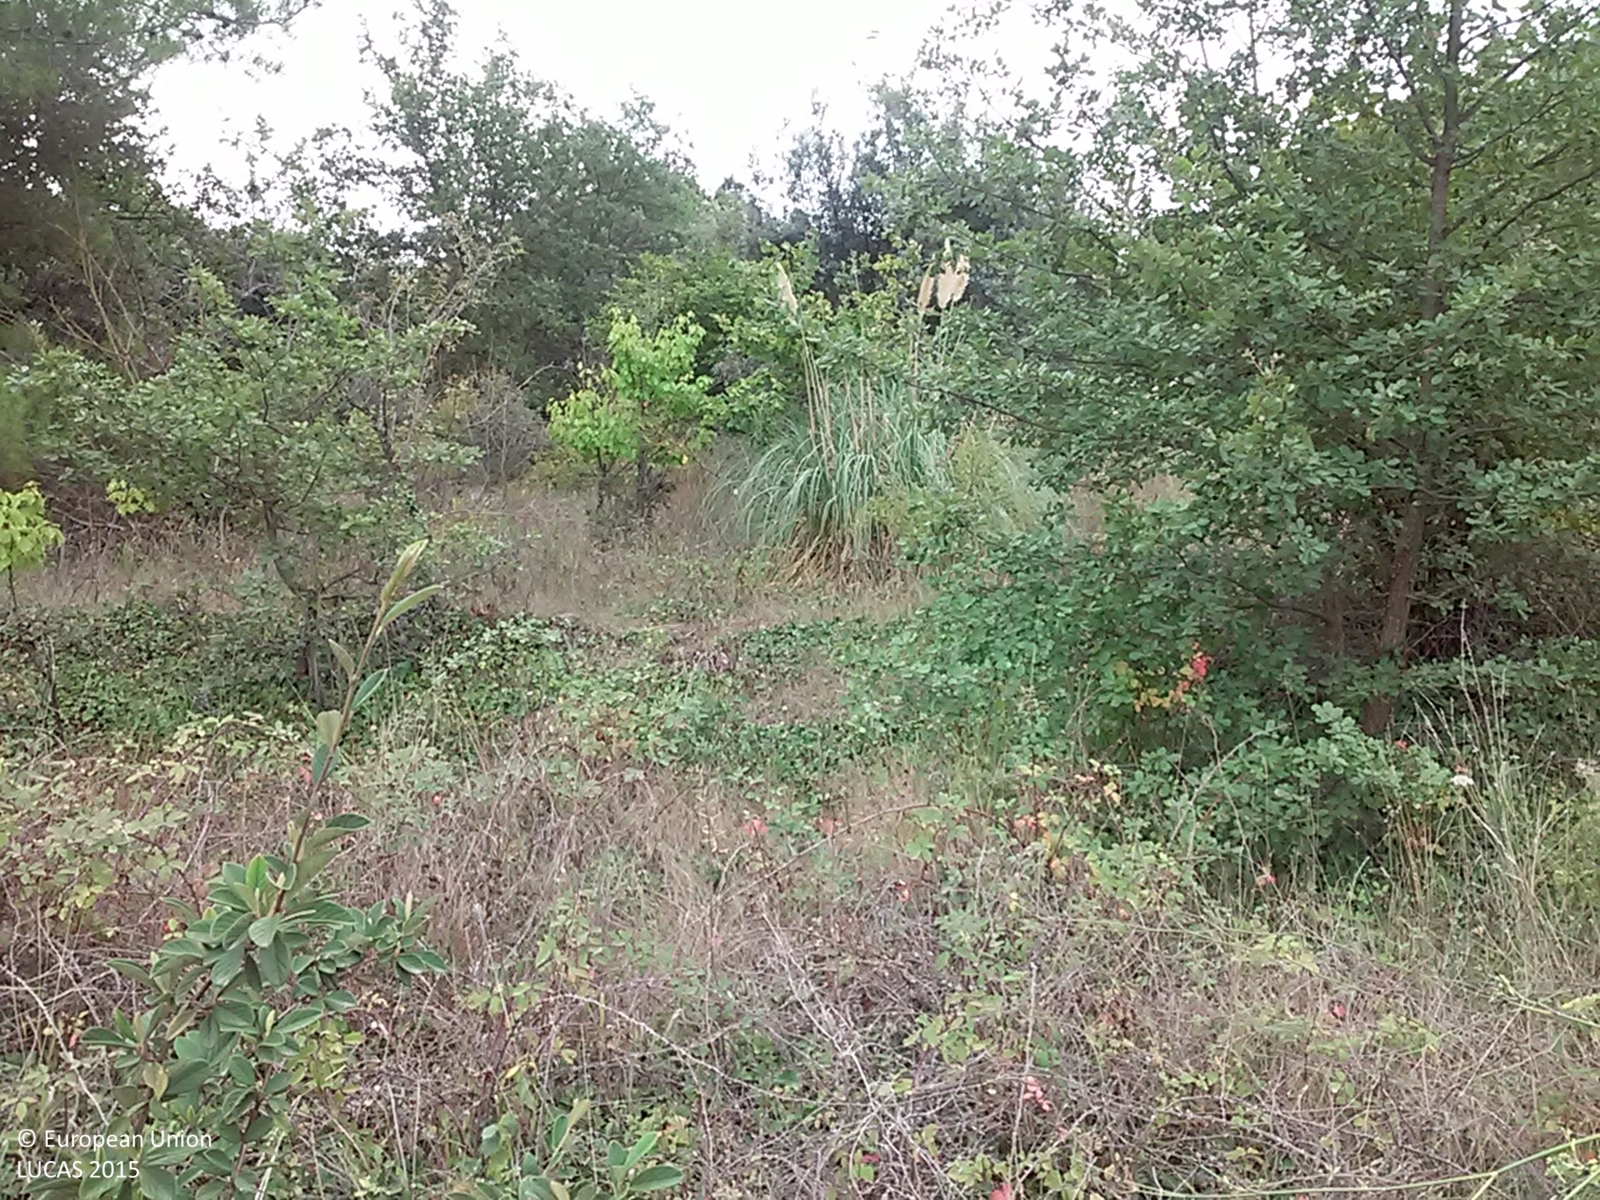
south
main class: Shrubland
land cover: Shrubland with sparse tree cover
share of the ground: 50 - 75 %
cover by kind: shrubs 65 %, herbaceous plants 30 %, coniferous forest trees 5 %
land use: Abandoned areas
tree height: < 5 m
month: September
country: ES
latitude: 41.1446
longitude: 0.8061
